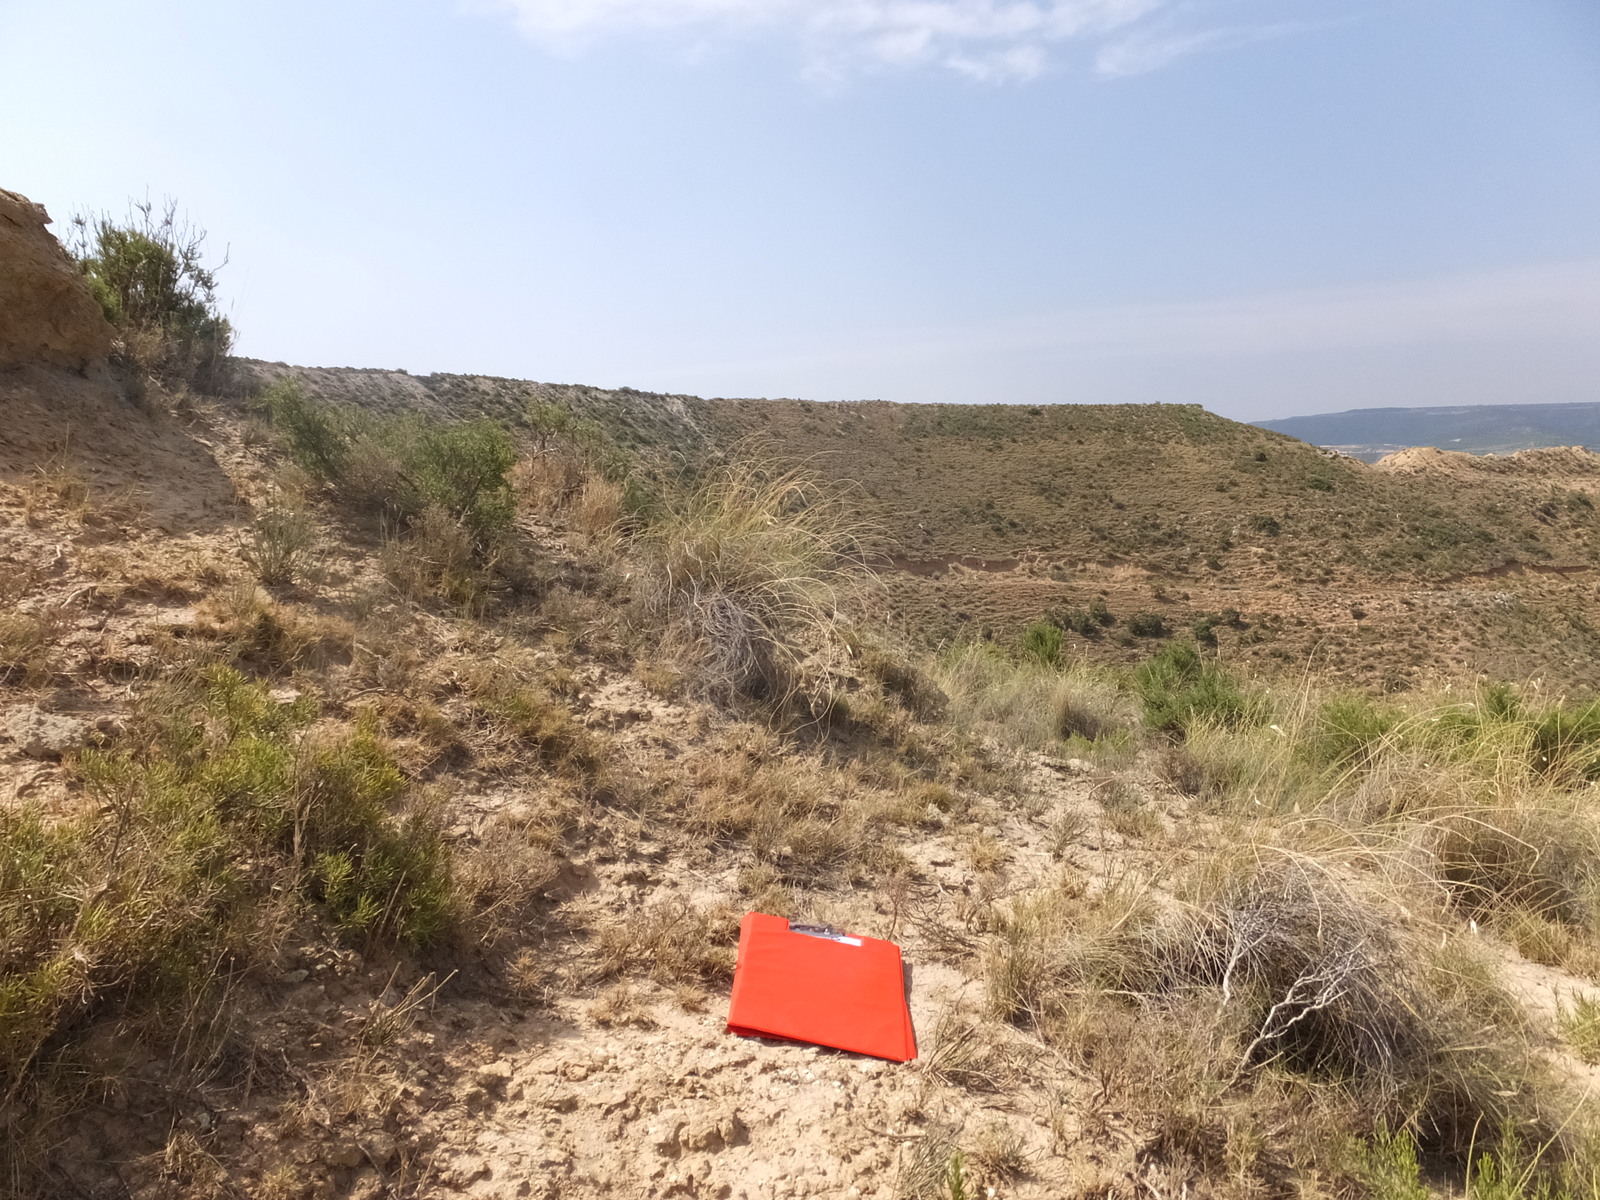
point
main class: Shrubland
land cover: Shrubland without tree cover
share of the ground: > 75 %
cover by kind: shrubs 65 %, consolidated bare surface 20 %, herbaceous plants 15 %
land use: Semi-natural and natural areas not in use
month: August
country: ES
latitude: 41.5545
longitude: 0.3352
